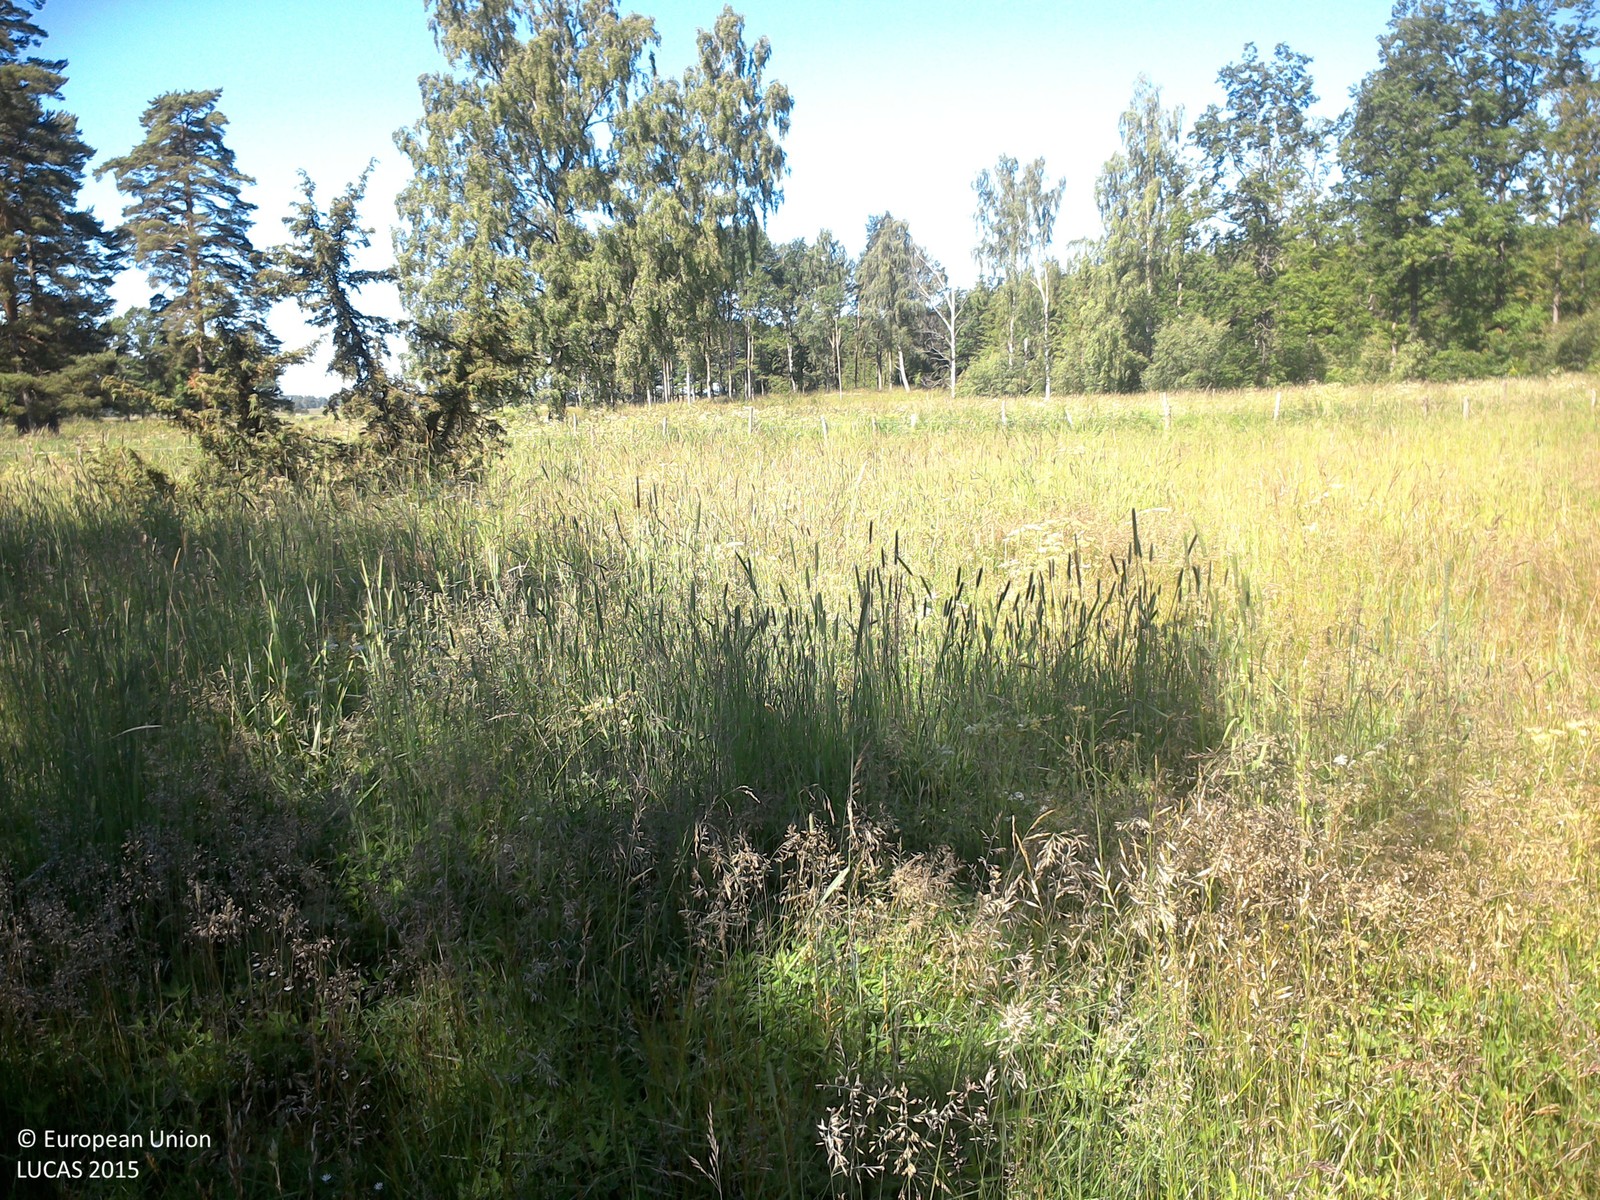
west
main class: Grassland
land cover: Grassland with sparse tree/shrub cover
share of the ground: > 75 %
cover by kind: herbaceous plants 95 %, broadleaved forest trees 5 %
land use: Agriculture (excluding fallow land and kitchen gardens)
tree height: > 5 m
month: July
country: SE
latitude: 58.4016
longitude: 15.3501
